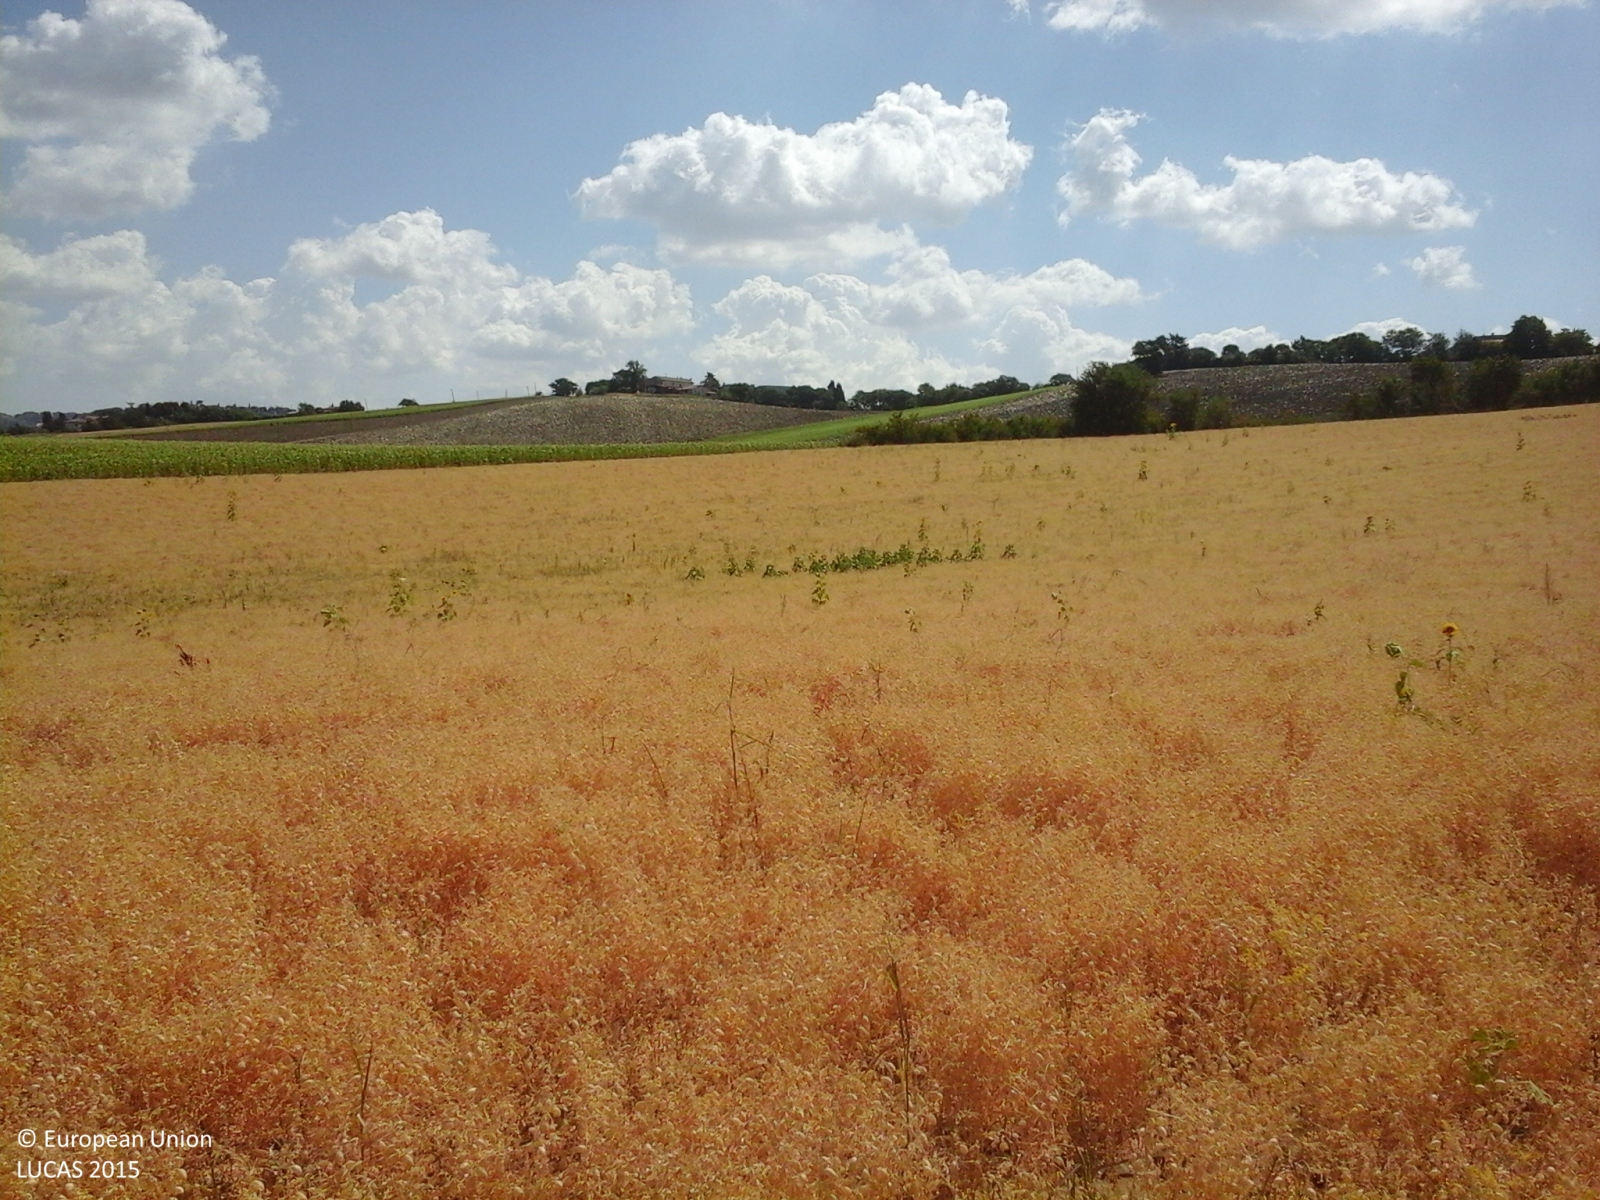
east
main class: Cropland
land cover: Dry pulses
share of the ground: > 75 %
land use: Agriculture (excluding fallow land and kitchen gardens)
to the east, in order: Dry pulses; Sunflower; Grass margins; Durum wheat
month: July
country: IT
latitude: 43.2843
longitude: 13.3803
